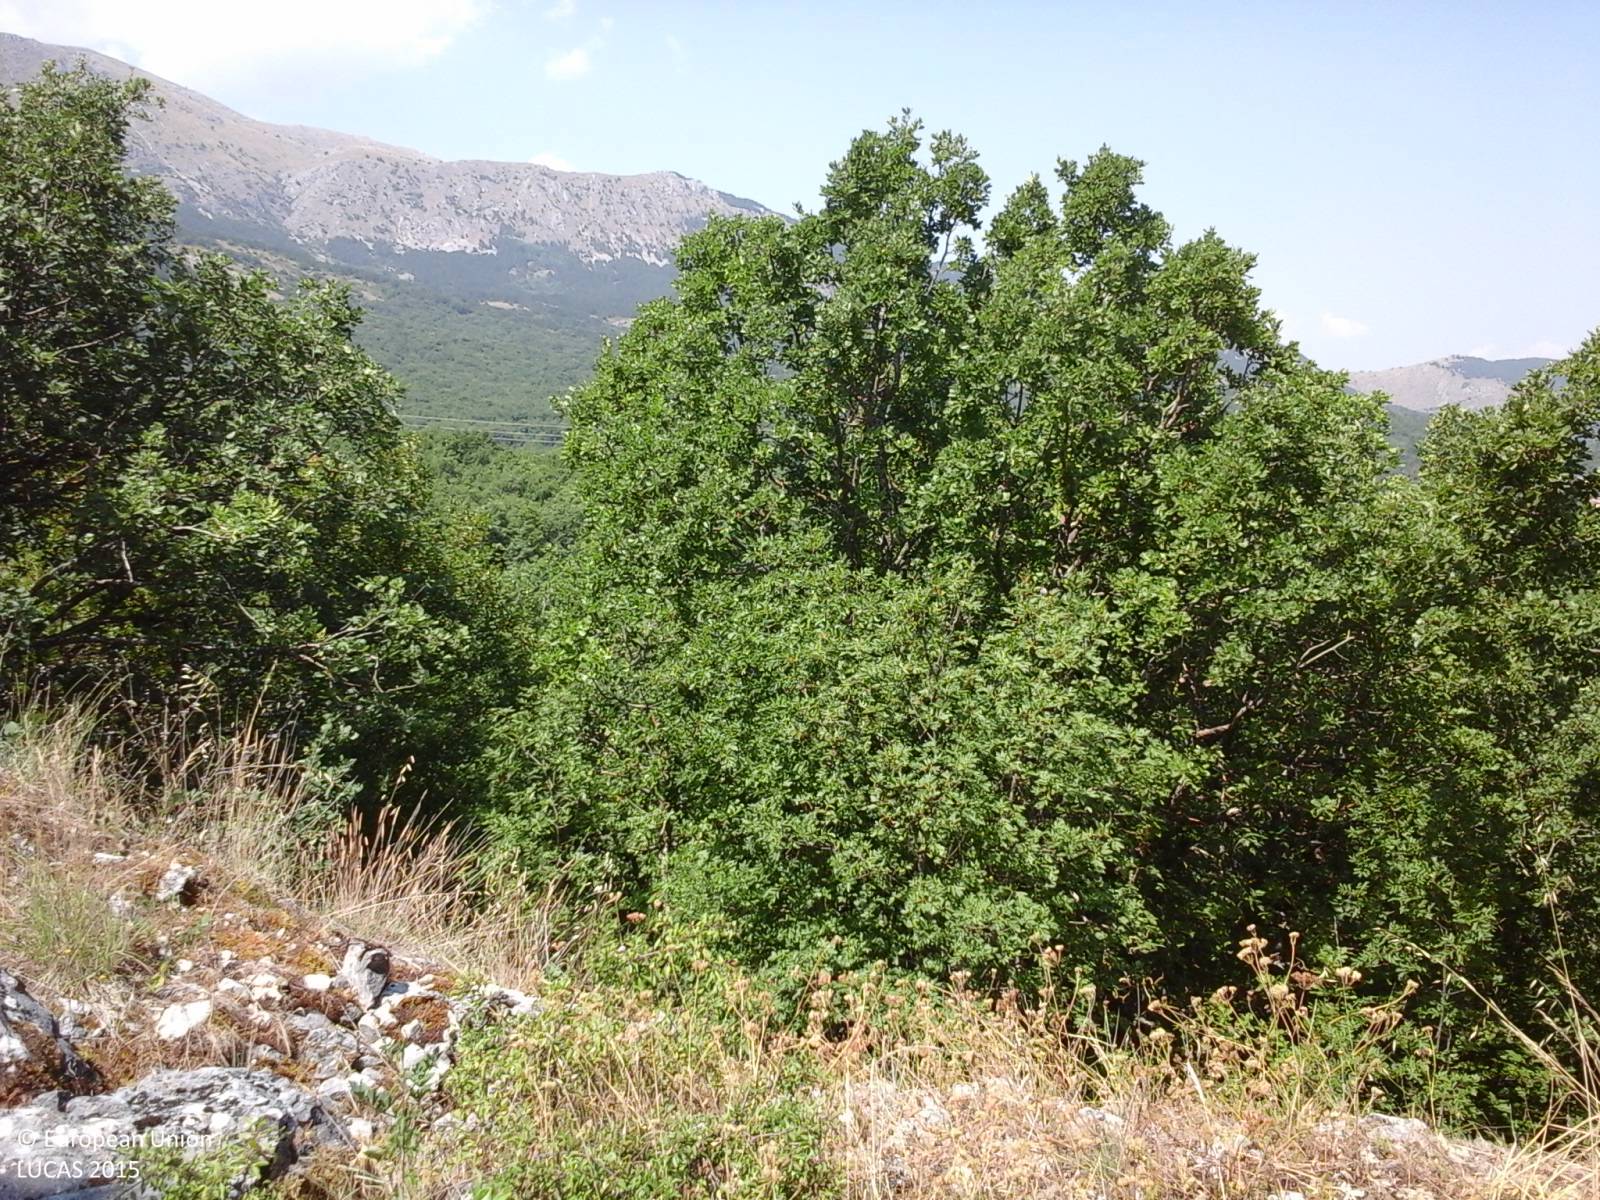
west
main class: Grassland
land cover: Grassland with sparse tree/shrub cover
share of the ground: > 75 %
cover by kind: herbaceous plants 90 %, broadleaved forest trees 5 %, shrubs 5 %
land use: Agriculture (excluding fallow land and kitchen gardens)
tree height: > 5 m
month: July
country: IT
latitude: 42.2873
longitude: 13.4693
